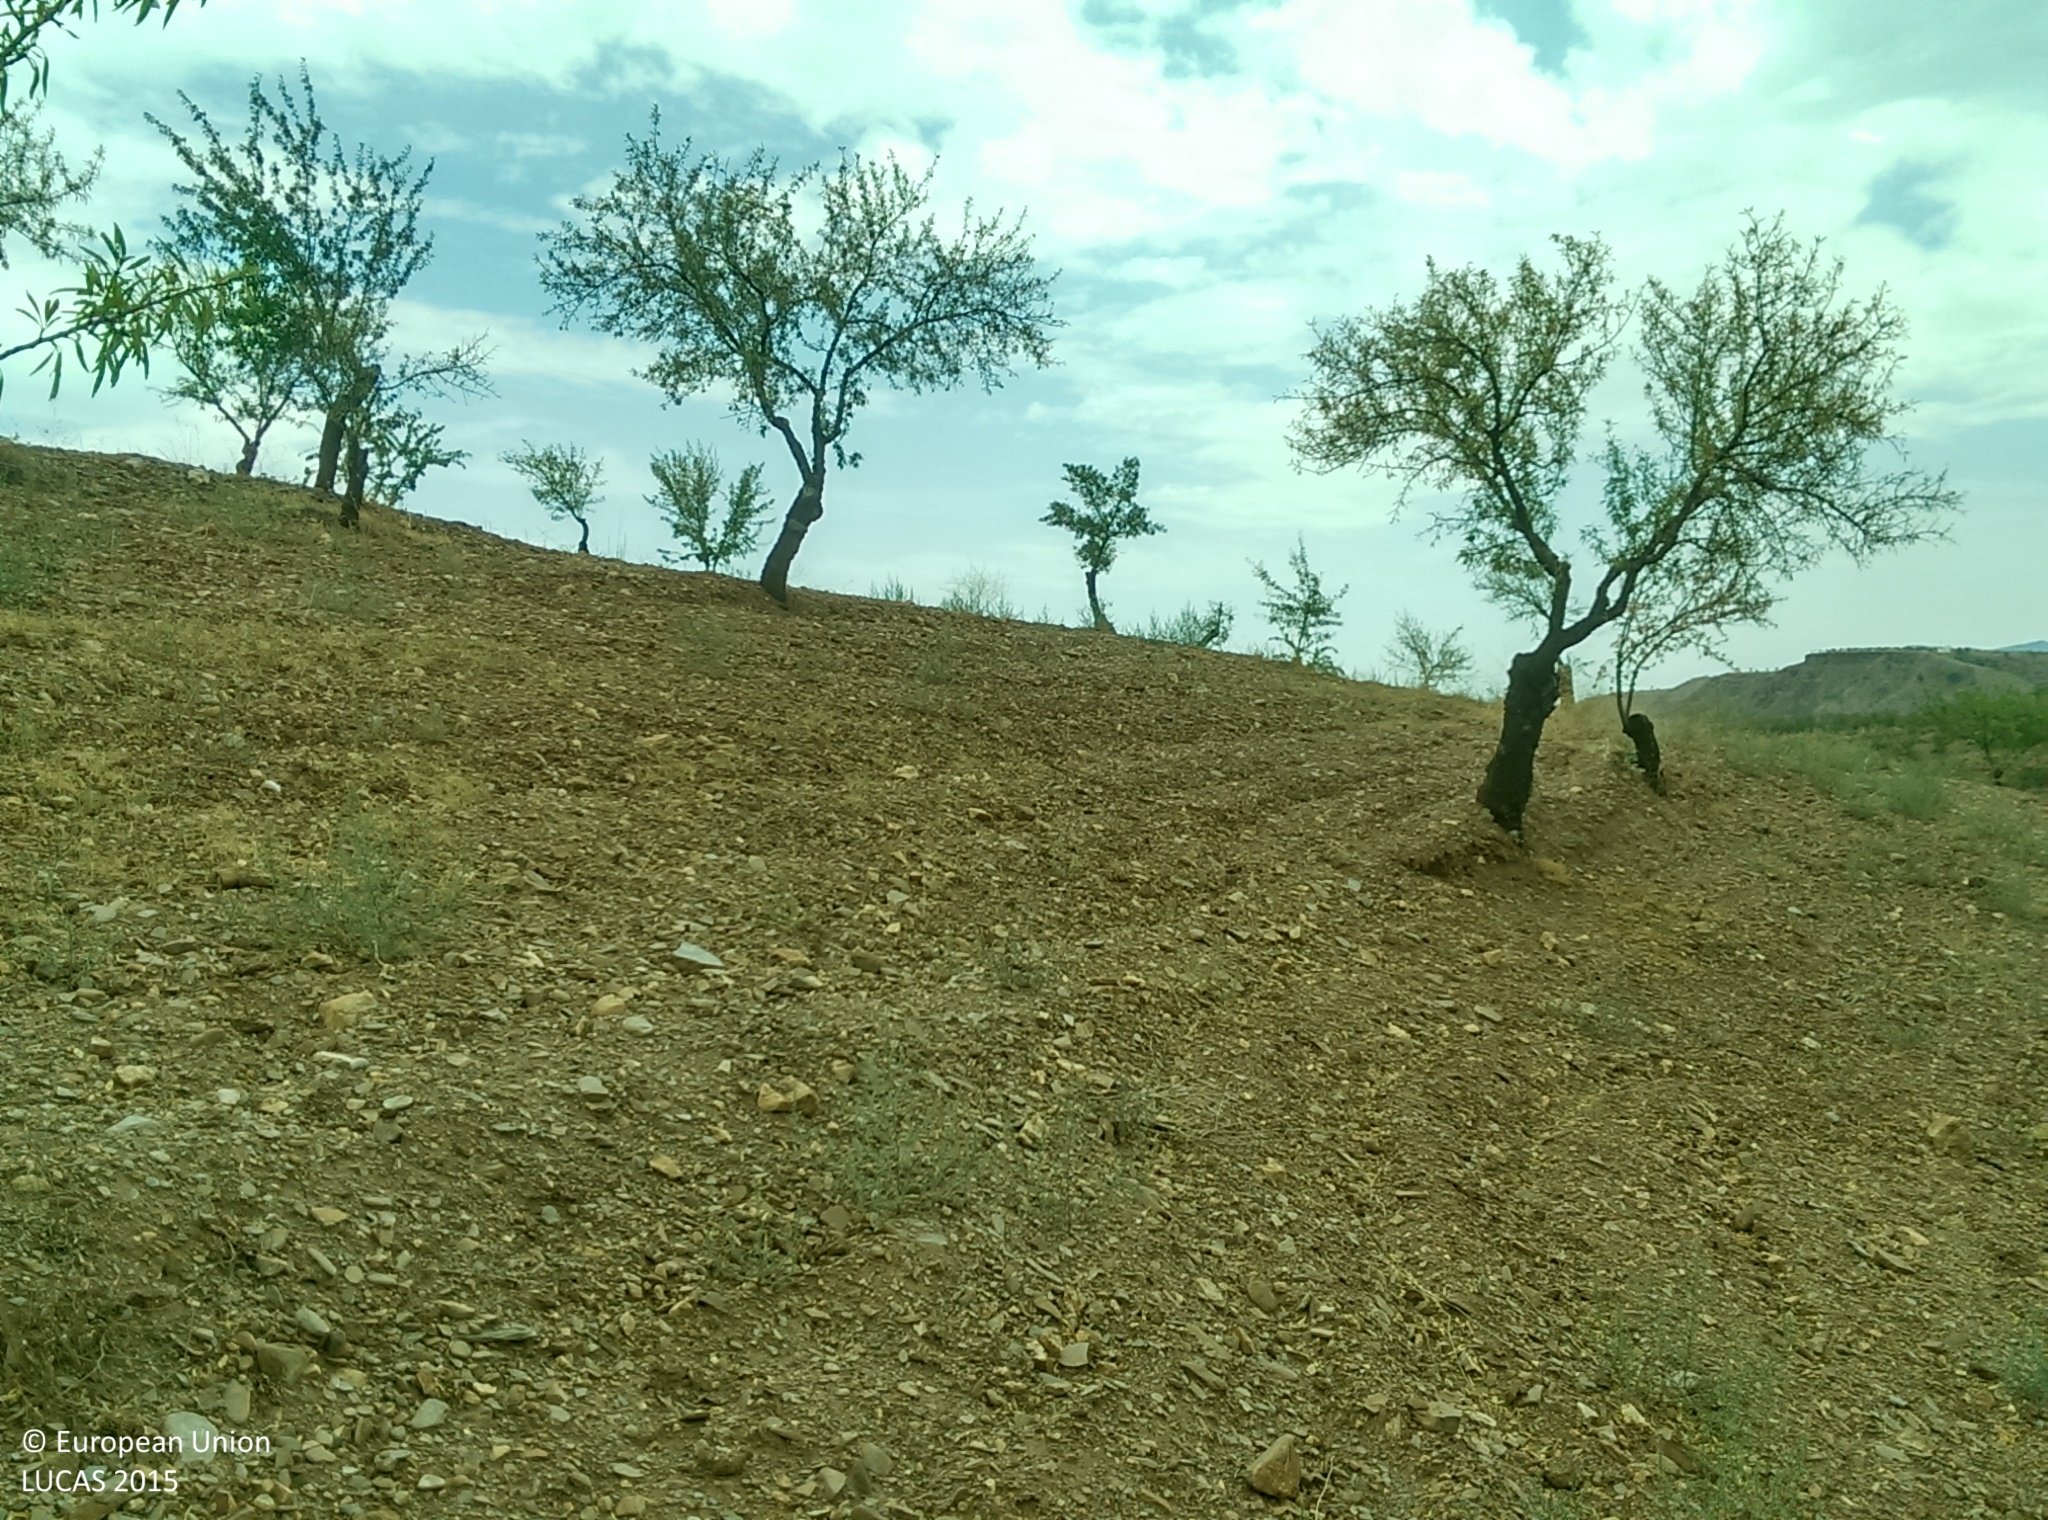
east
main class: Cropland
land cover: Nuts trees
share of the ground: < 10 %
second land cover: Spontaneously vegetated surfaces
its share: 10 - 25 %
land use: Agriculture (excluding fallow land and kitchen gardens)
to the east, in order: Nuts trees; Spontaneously vegetated surfaces; Tracks; Grassland without tree/shrub cover; Grass margins; Shrubland with sparse tree cover; Tracks; Spontaneously vegetated surfaces; Vineyards
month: July
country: ES
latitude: 37.1943
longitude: -2.9054
